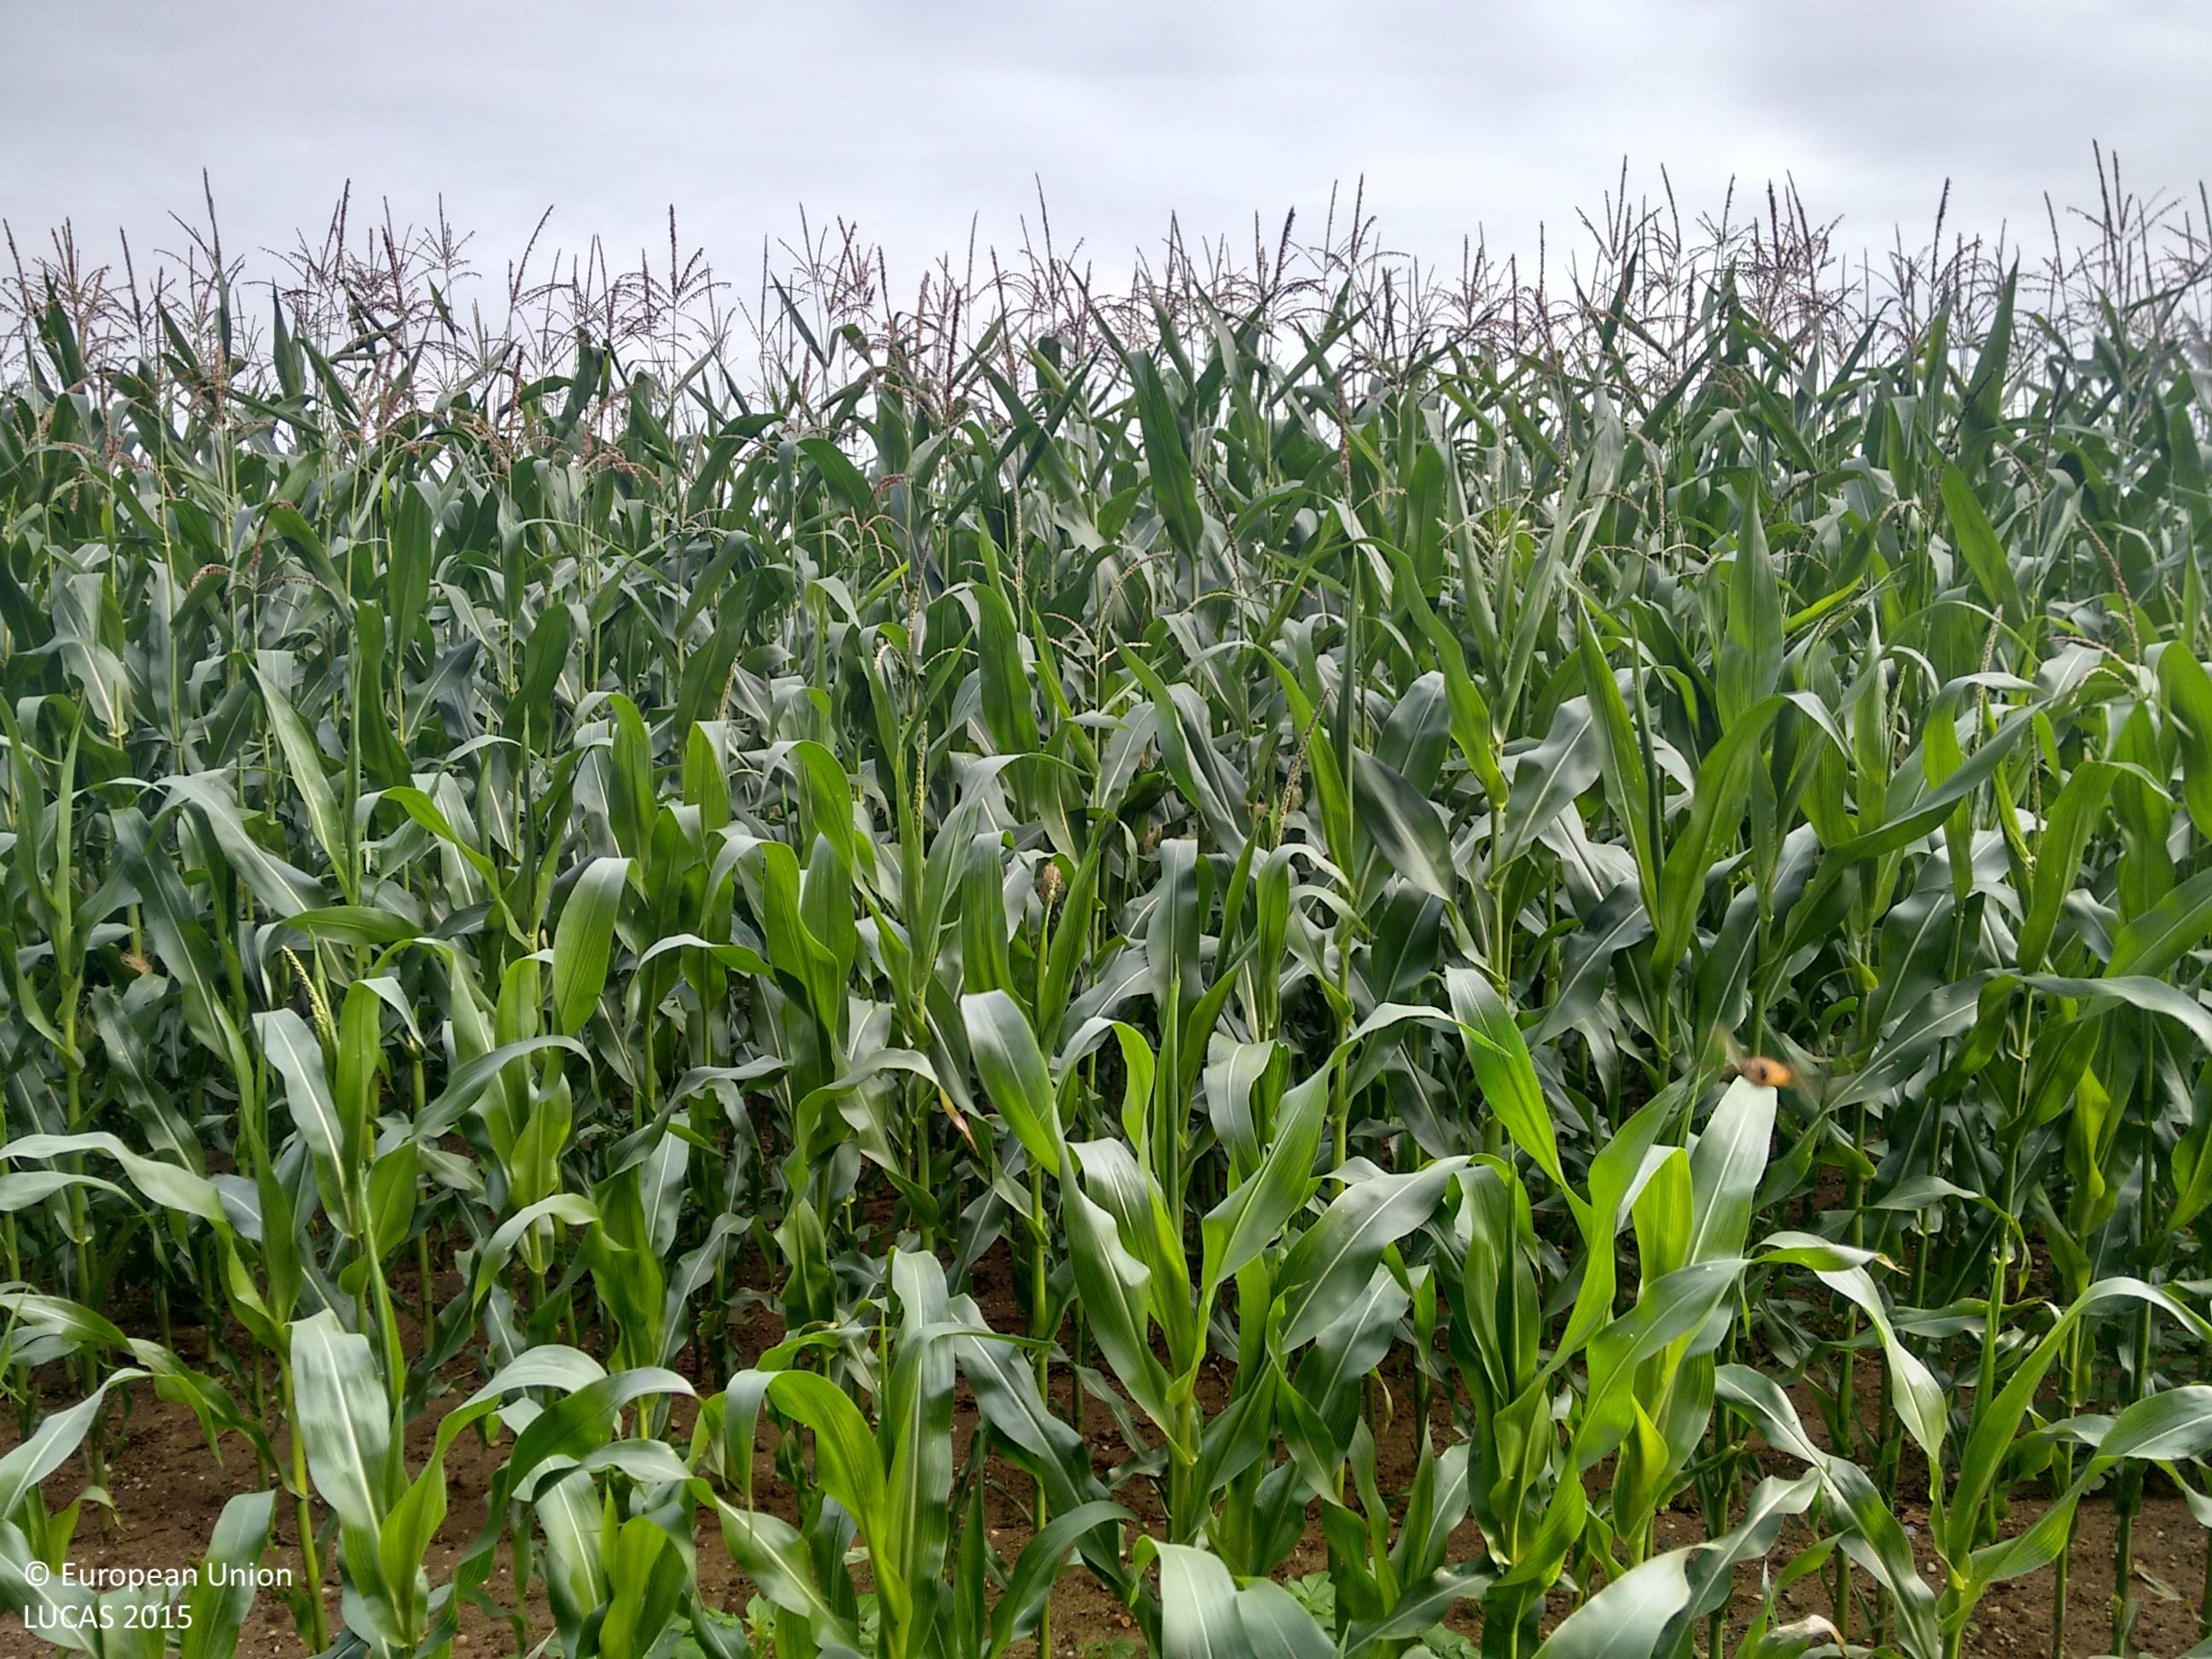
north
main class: Cropland
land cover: Maize
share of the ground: > 75 %
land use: Agriculture (excluding fallow land and kitchen gardens)
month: August
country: GB
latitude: 52.0998
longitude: 1.3814
